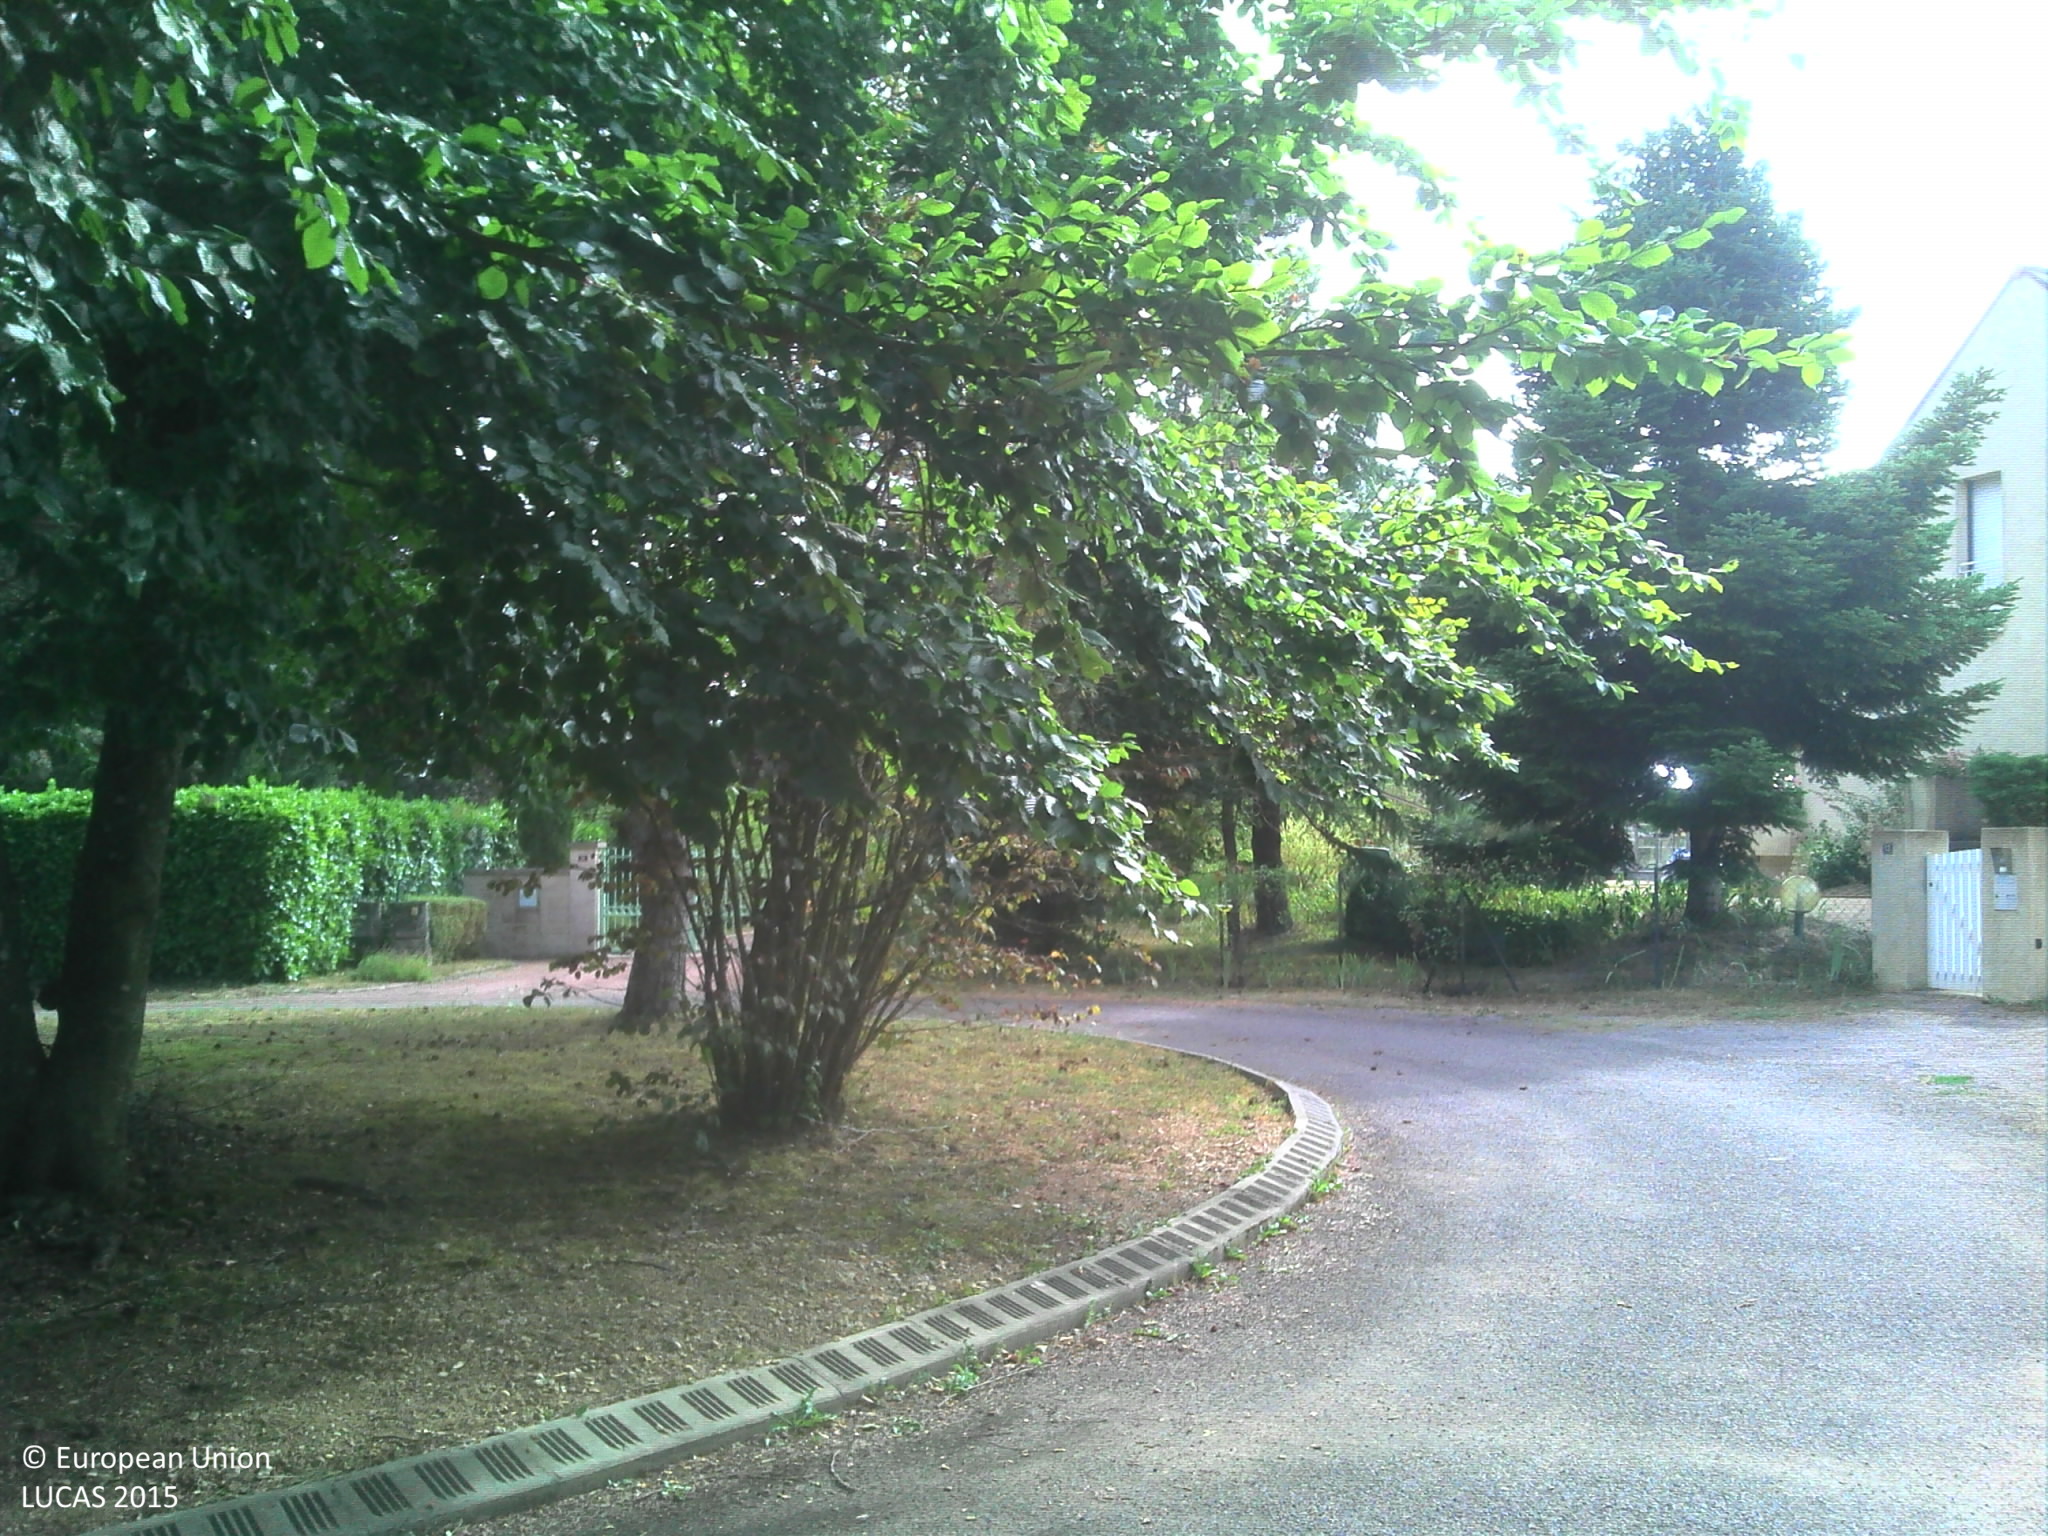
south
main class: Woodland
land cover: Broadleaved woodland
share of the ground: > 75 %
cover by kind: broadleaved forest trees 65 %, herbaceous plants 35 %
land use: Residential
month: July
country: FR
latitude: 46.8009
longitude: 4.7732
